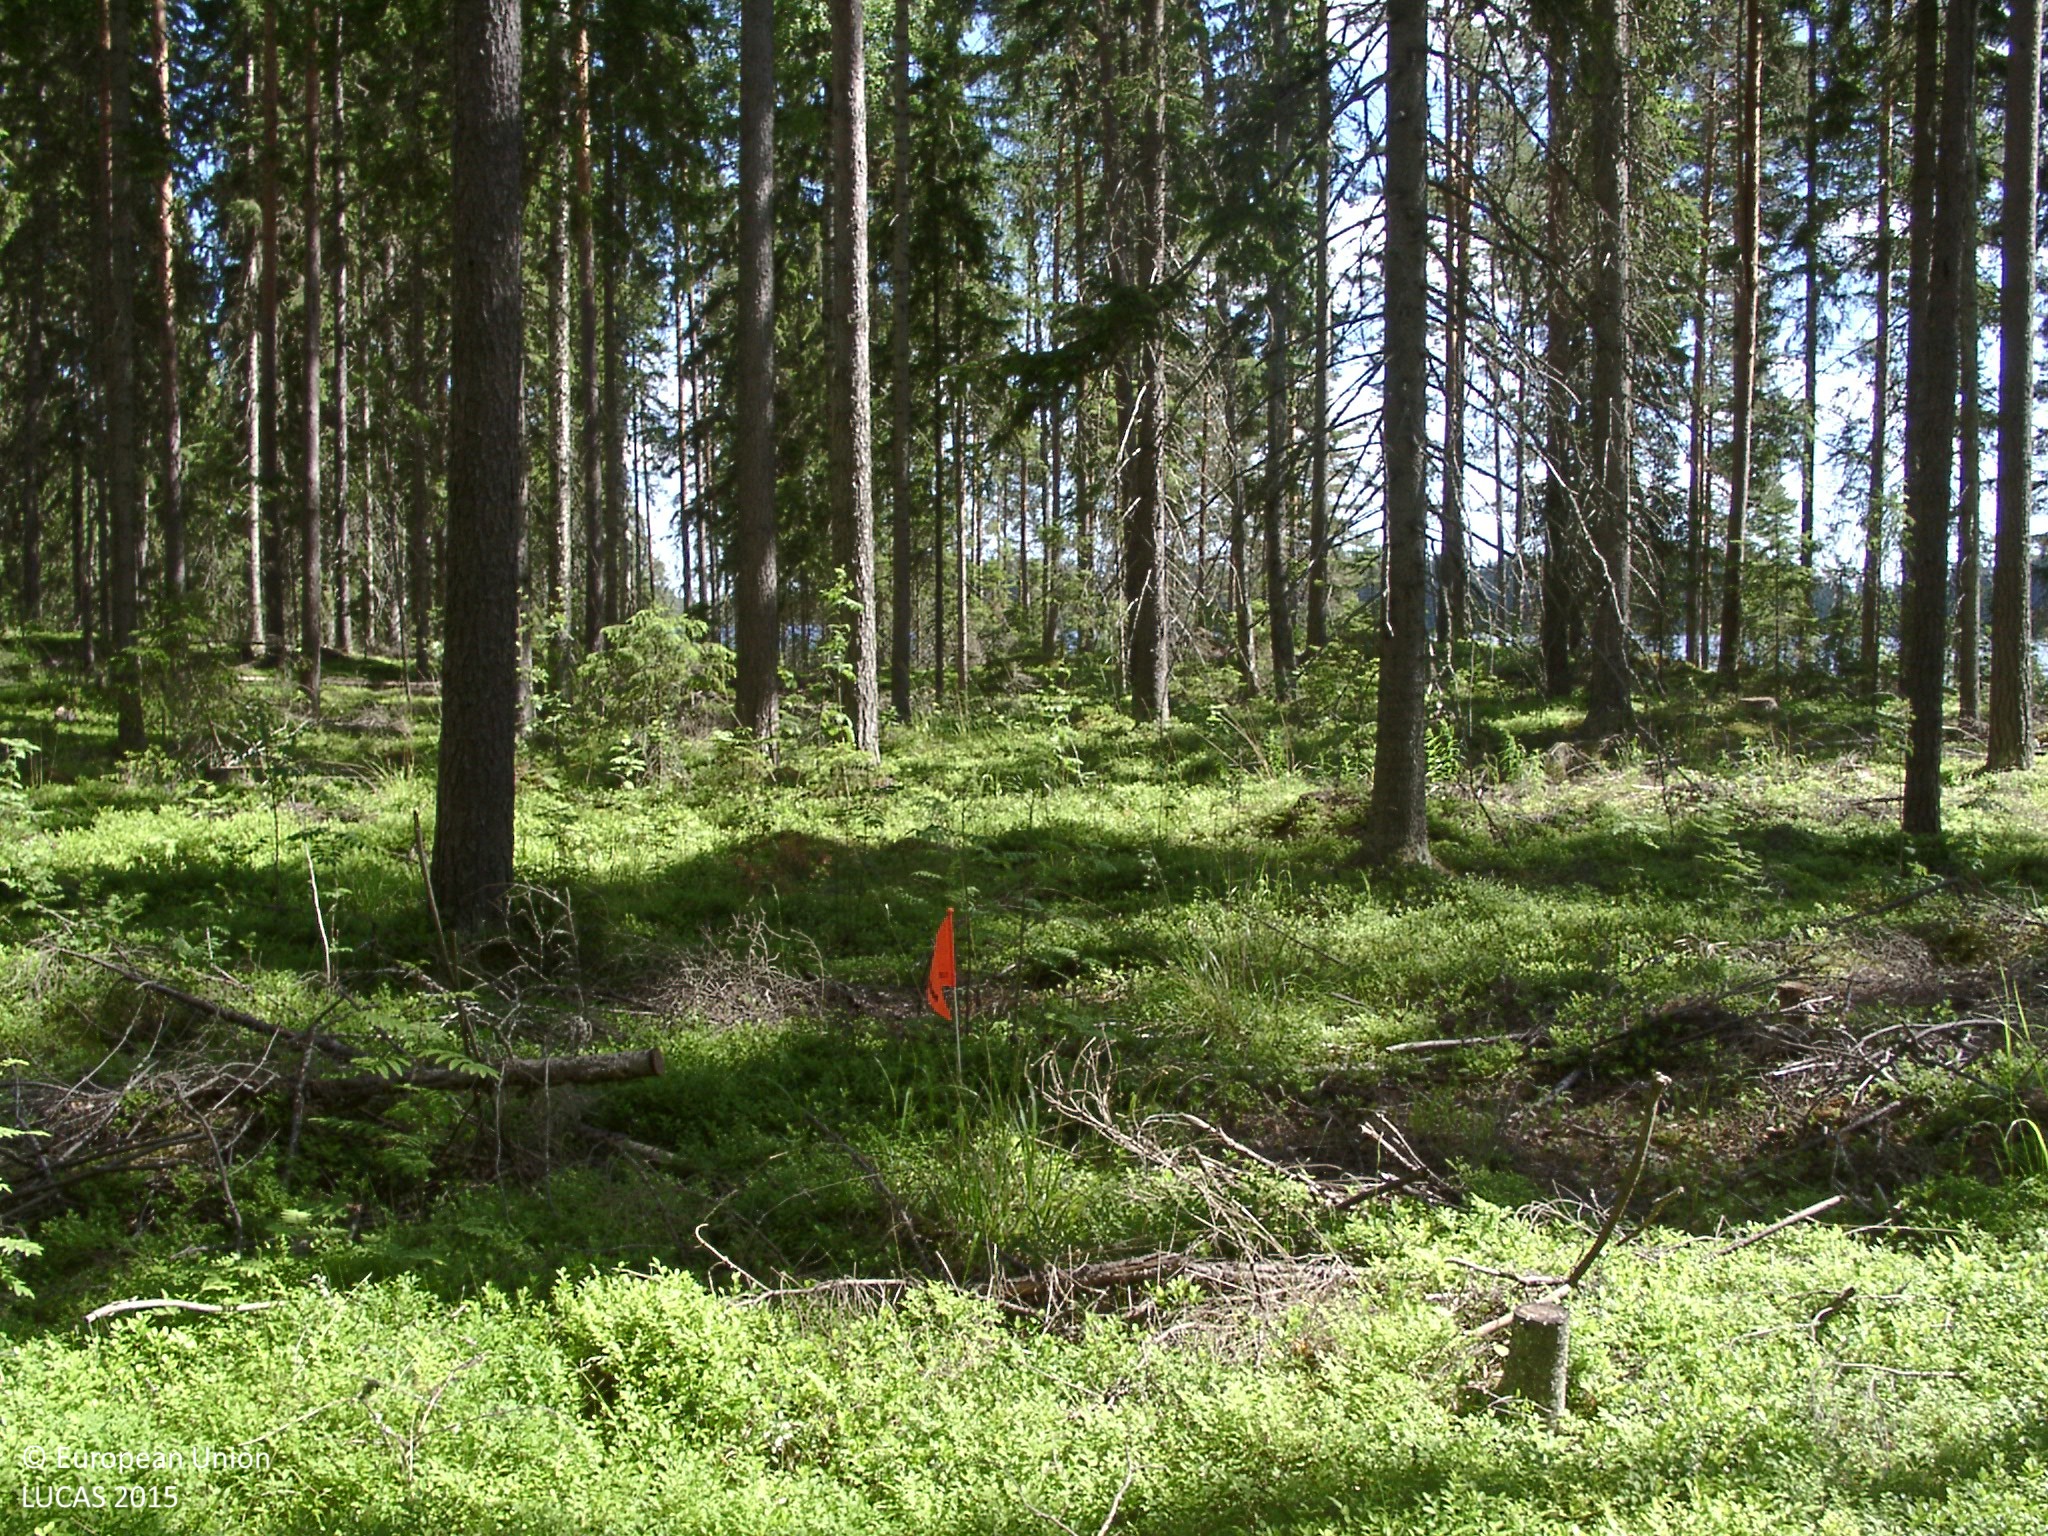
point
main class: Woodland
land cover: Other coniferous woodland
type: boreal forest
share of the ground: 50 - 75 %
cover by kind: coniferous forest trees 60 %, shrubs 30 %, broadleaved forest trees 5 %, herbaceous plants 5 %
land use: Forestry
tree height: > 5 m
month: June
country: FI
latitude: 62.0878
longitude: 25.0608
